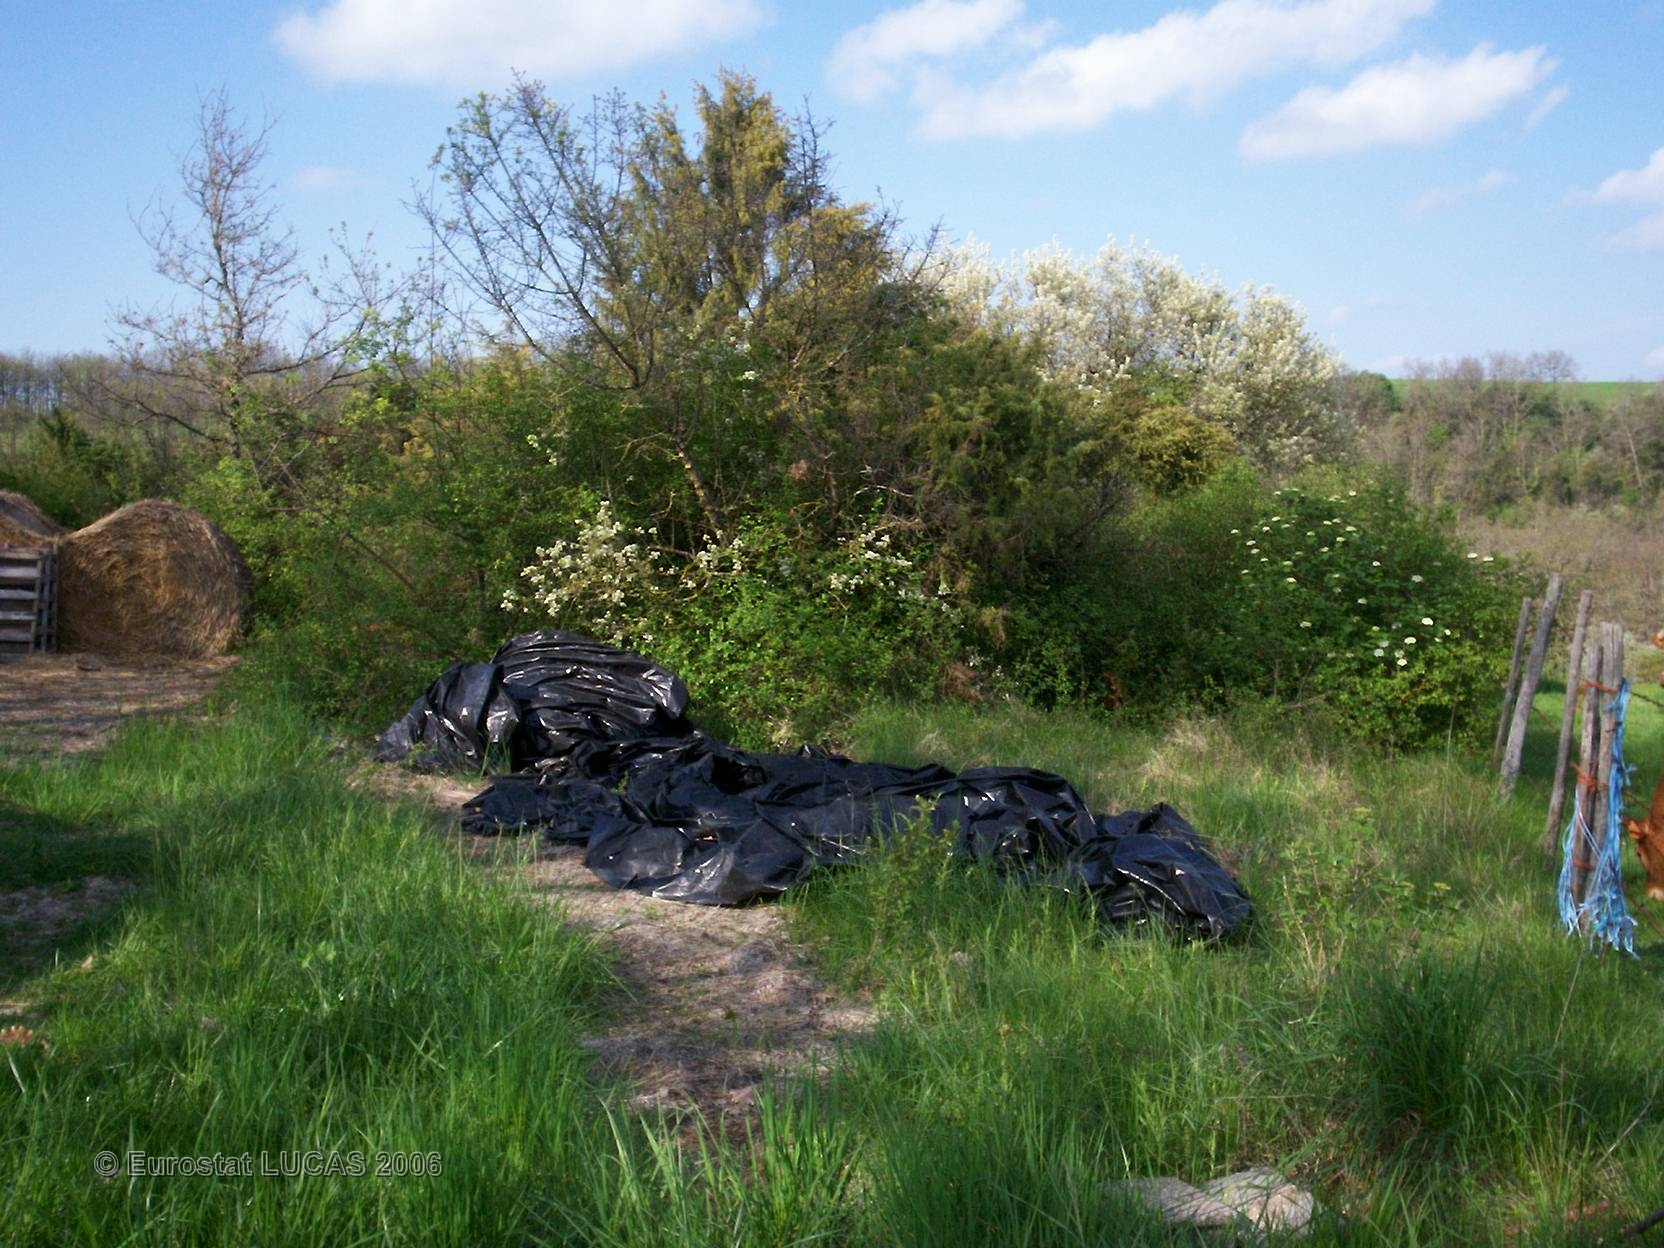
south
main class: Grassland
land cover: Grassland with sparse tree/shrub cover
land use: Agriculture (excluding fallow land and kitchen gardens)
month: April
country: FR
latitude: 44.0397
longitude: 1.9785
